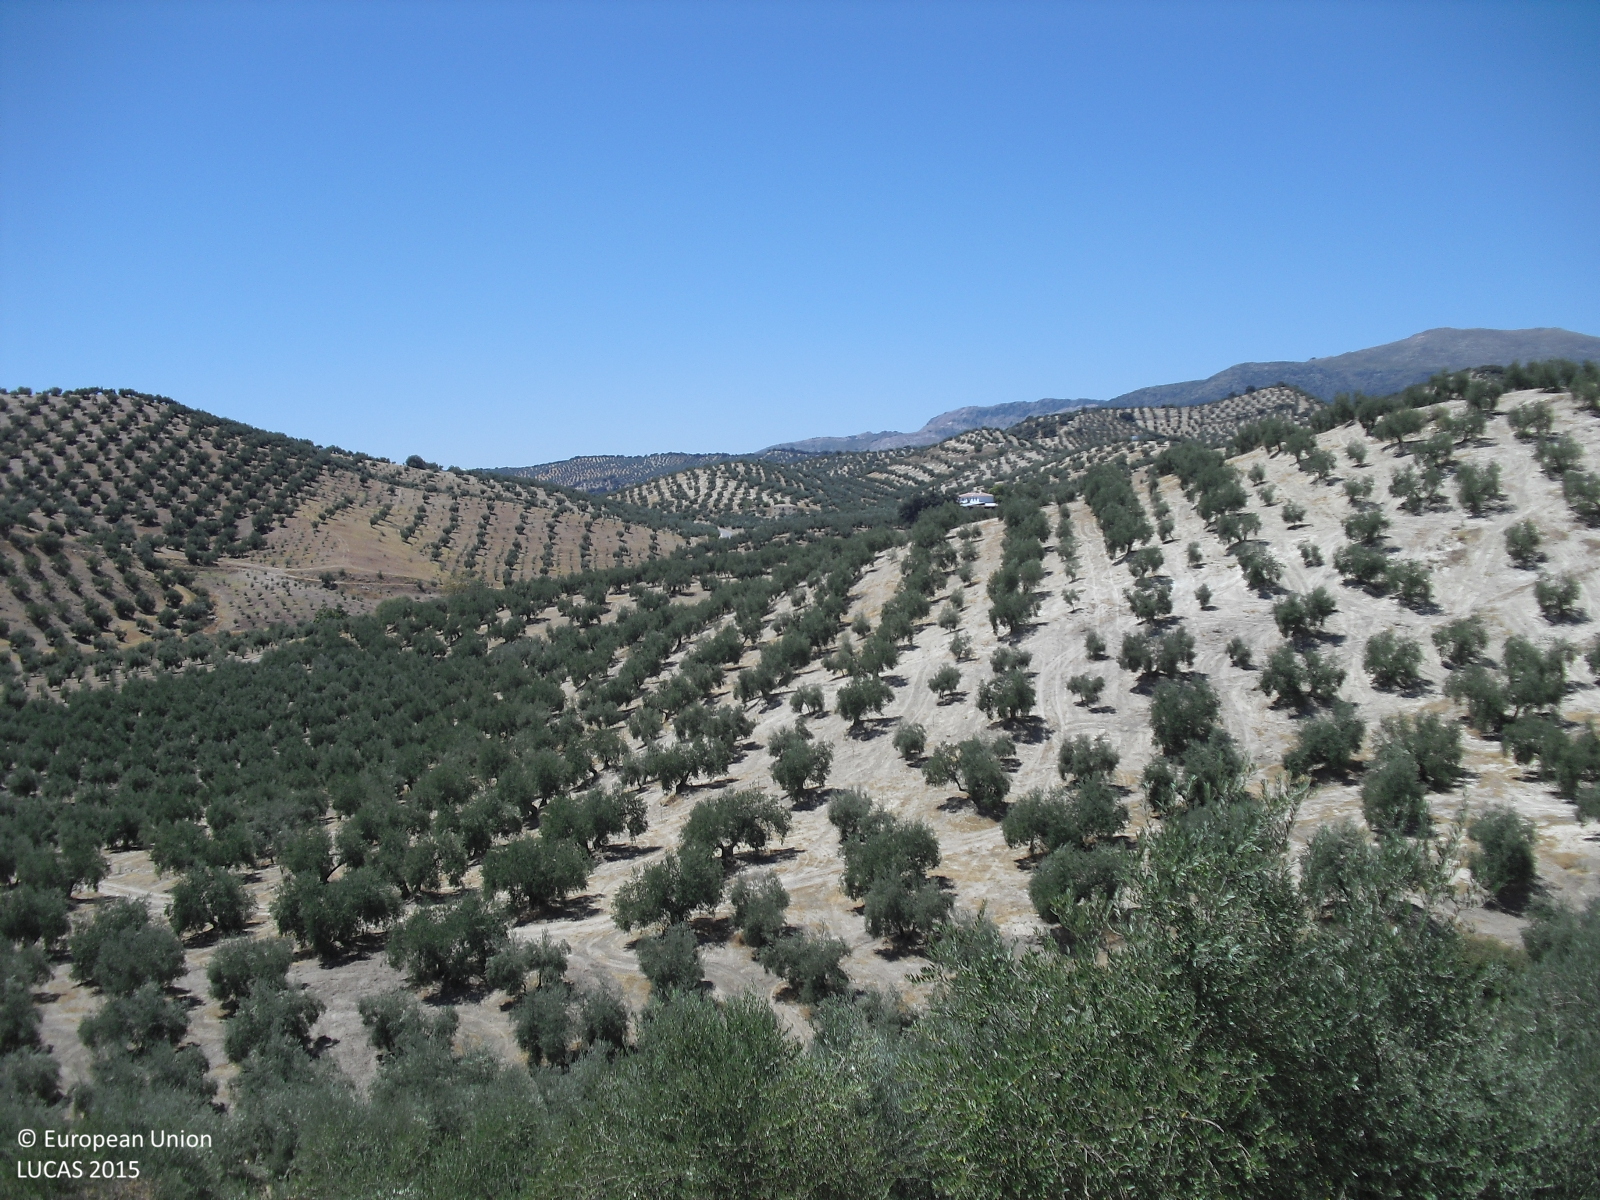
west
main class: Cropland
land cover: Olive groves
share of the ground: 25 - 50 %
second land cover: Spontaneously vegetated surfaces
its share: 25 - 50 %
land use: Agriculture (excluding fallow land and kitchen gardens)
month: August
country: ES
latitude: 37.3432
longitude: -4.1641
